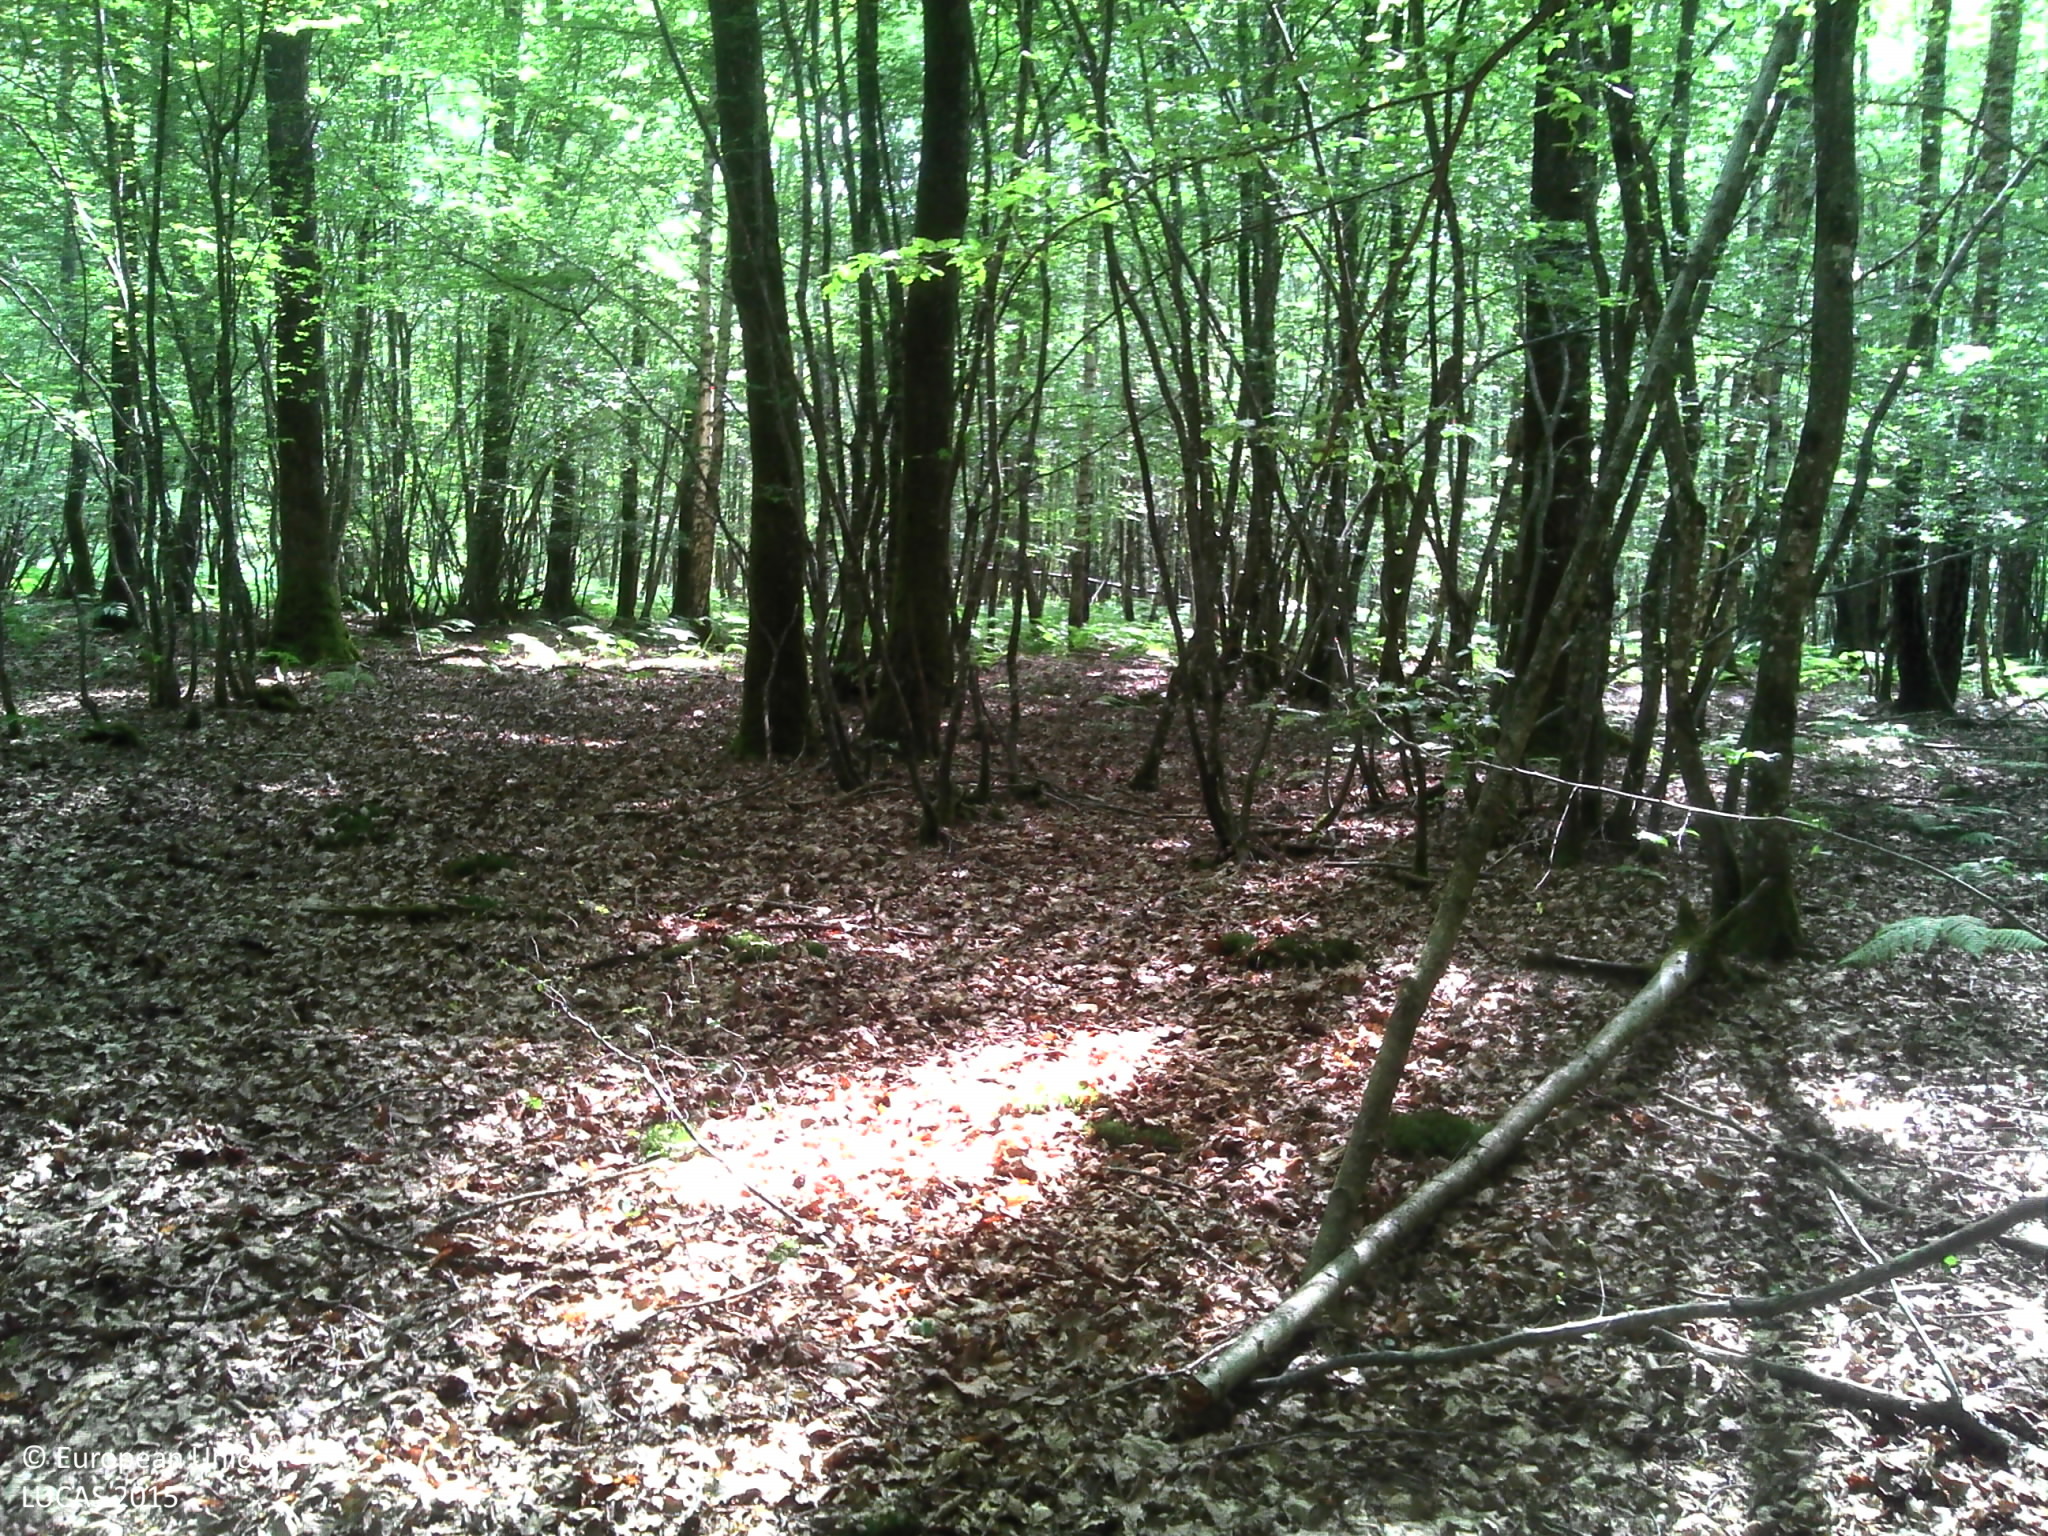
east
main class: Woodland
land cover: Broadleaved woodland
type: mesophytic deciduous forest
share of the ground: > 75 %
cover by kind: broadleaved forest trees 90 %, herbaceous plants 5 %, lichens and mosses 5 %
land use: Forestry
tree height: > 5 m
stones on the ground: < 10 %
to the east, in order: Broadleaved woodland; Ditches and canals; Electric lines; Grass margins; Paved roads, cycling and walking lanes; Grass margins; Broadleaved woodland; Fences; Broadleaved woodland
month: June
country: FR
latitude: 48.0686
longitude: 3.5129
